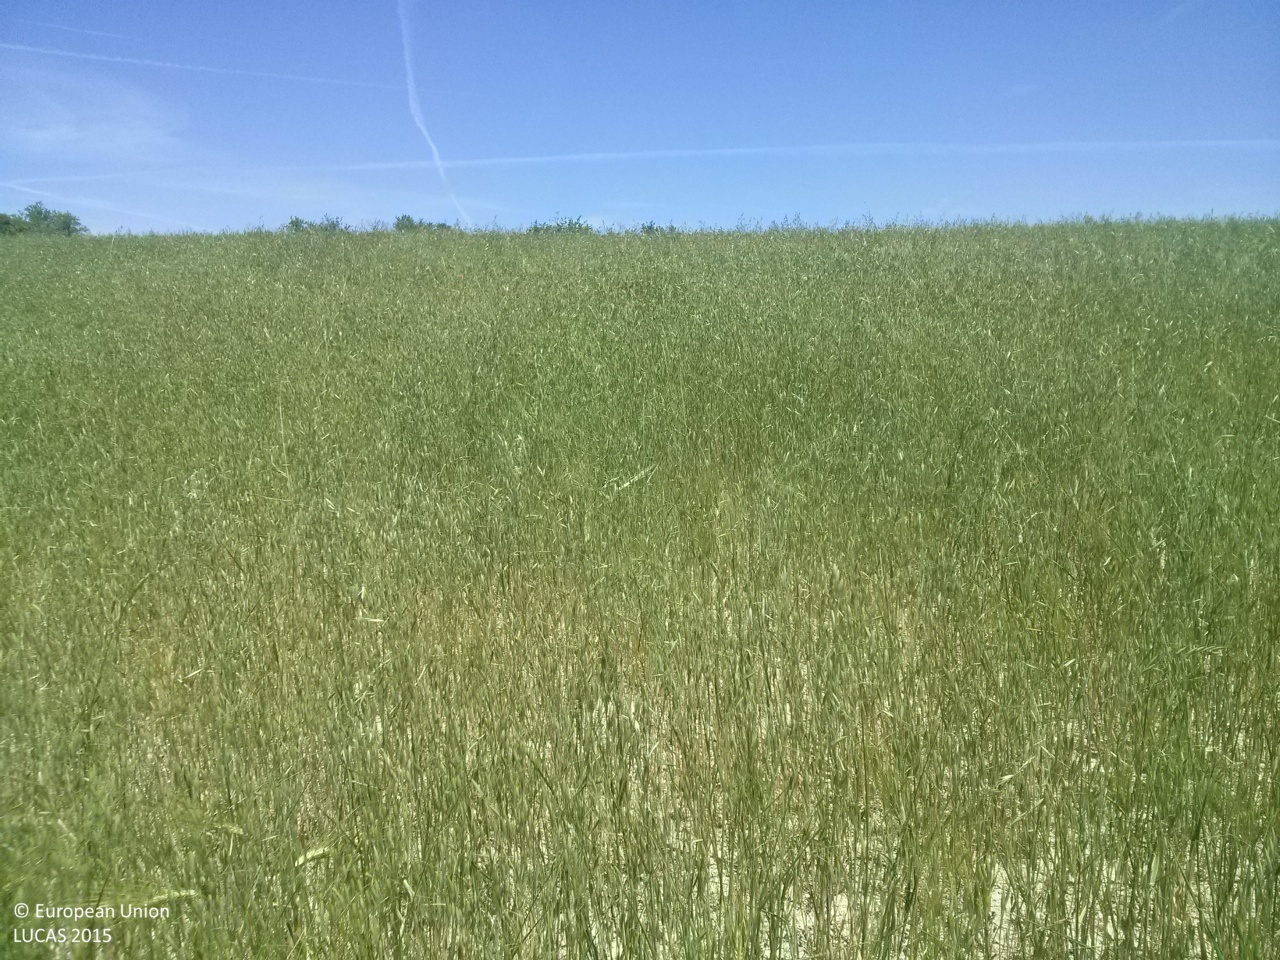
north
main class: Cropland
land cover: Mixed cereals for fodder
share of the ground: > 75 %
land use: Agriculture (excluding fallow land and kitchen gardens)
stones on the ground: < 10 %
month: May
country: ES
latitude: 39.9867
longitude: -2.7033
